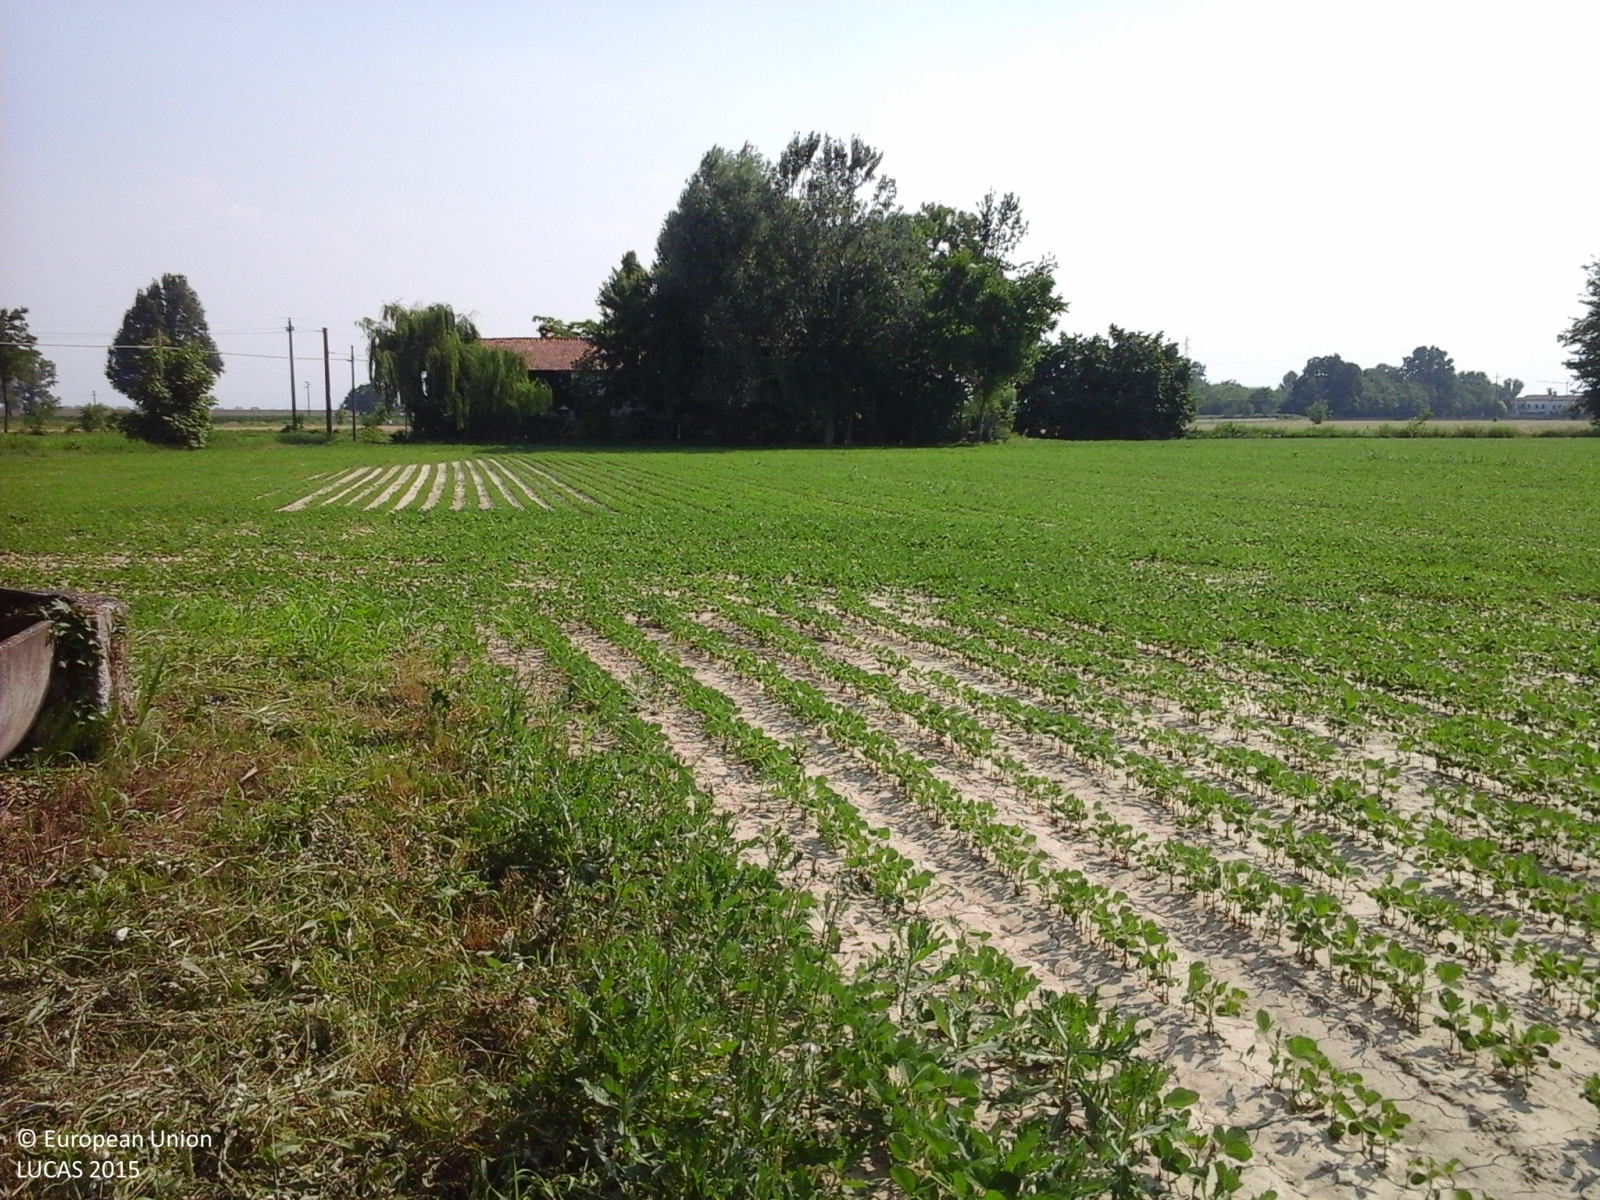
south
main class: Cropland
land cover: Soya
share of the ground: 25 - 50 %
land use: Agriculture (excluding fallow land and kitchen gardens)
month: June
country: IT
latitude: 45.1073
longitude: 9.6575
